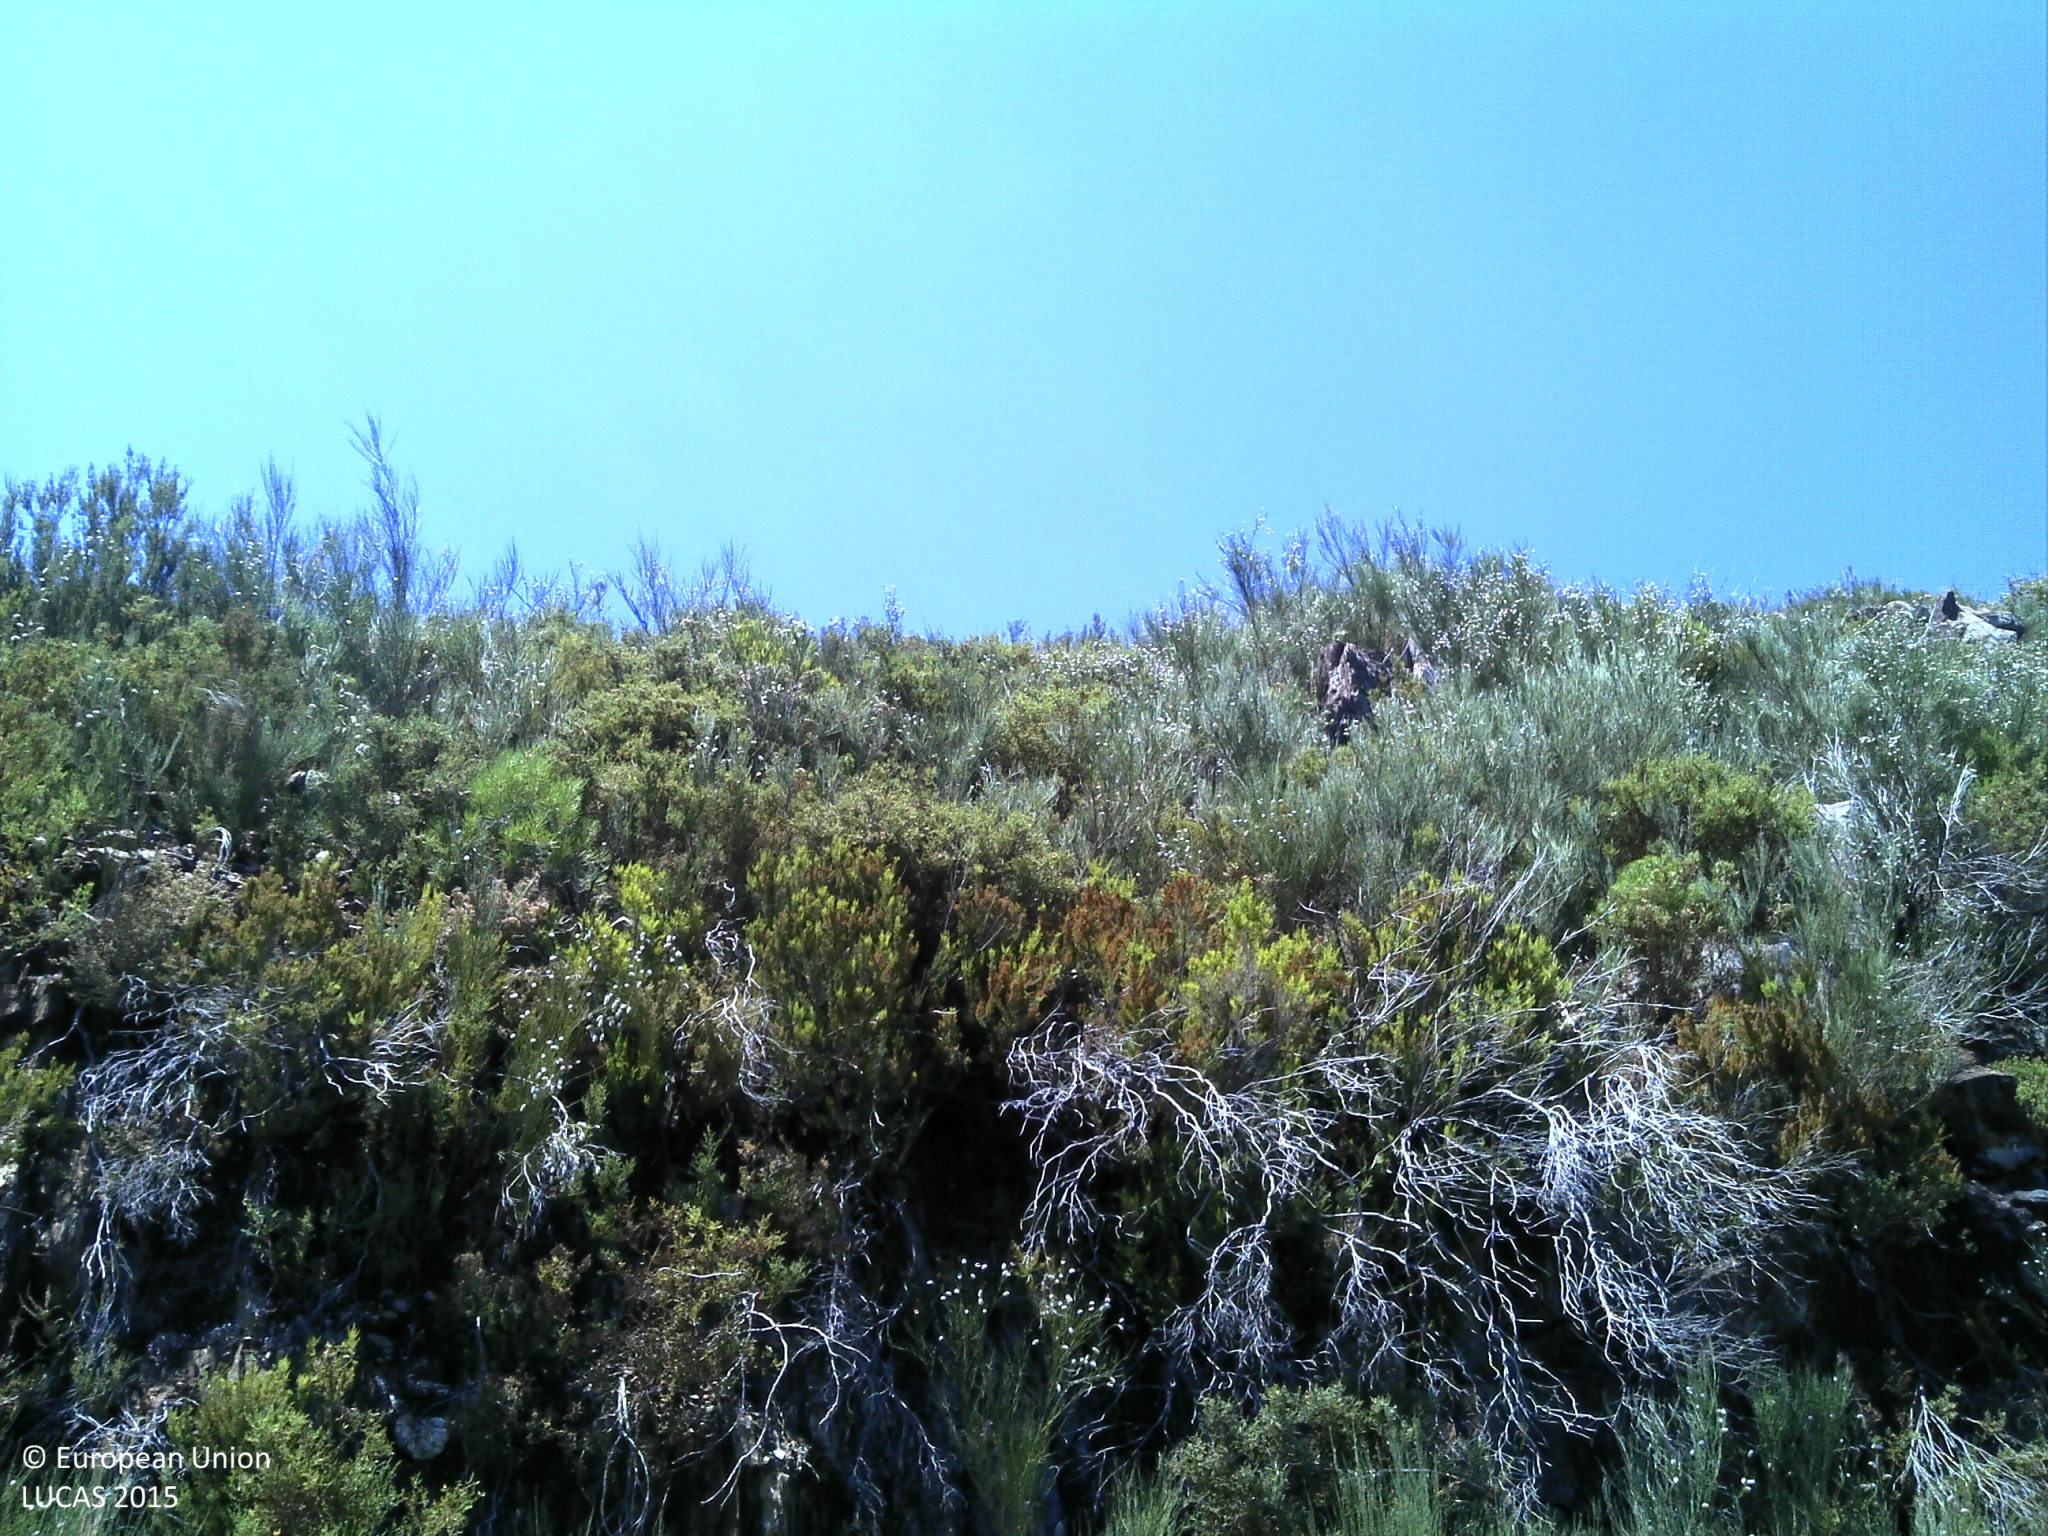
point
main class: Shrubland
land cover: Shrubland without tree cover
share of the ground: > 75 %
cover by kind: shrubs 85 %, unconsolidated bare surface 15 %
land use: Semi-natural and natural areas not in use
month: June
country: PT
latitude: 40.8233
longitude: -8.0954
